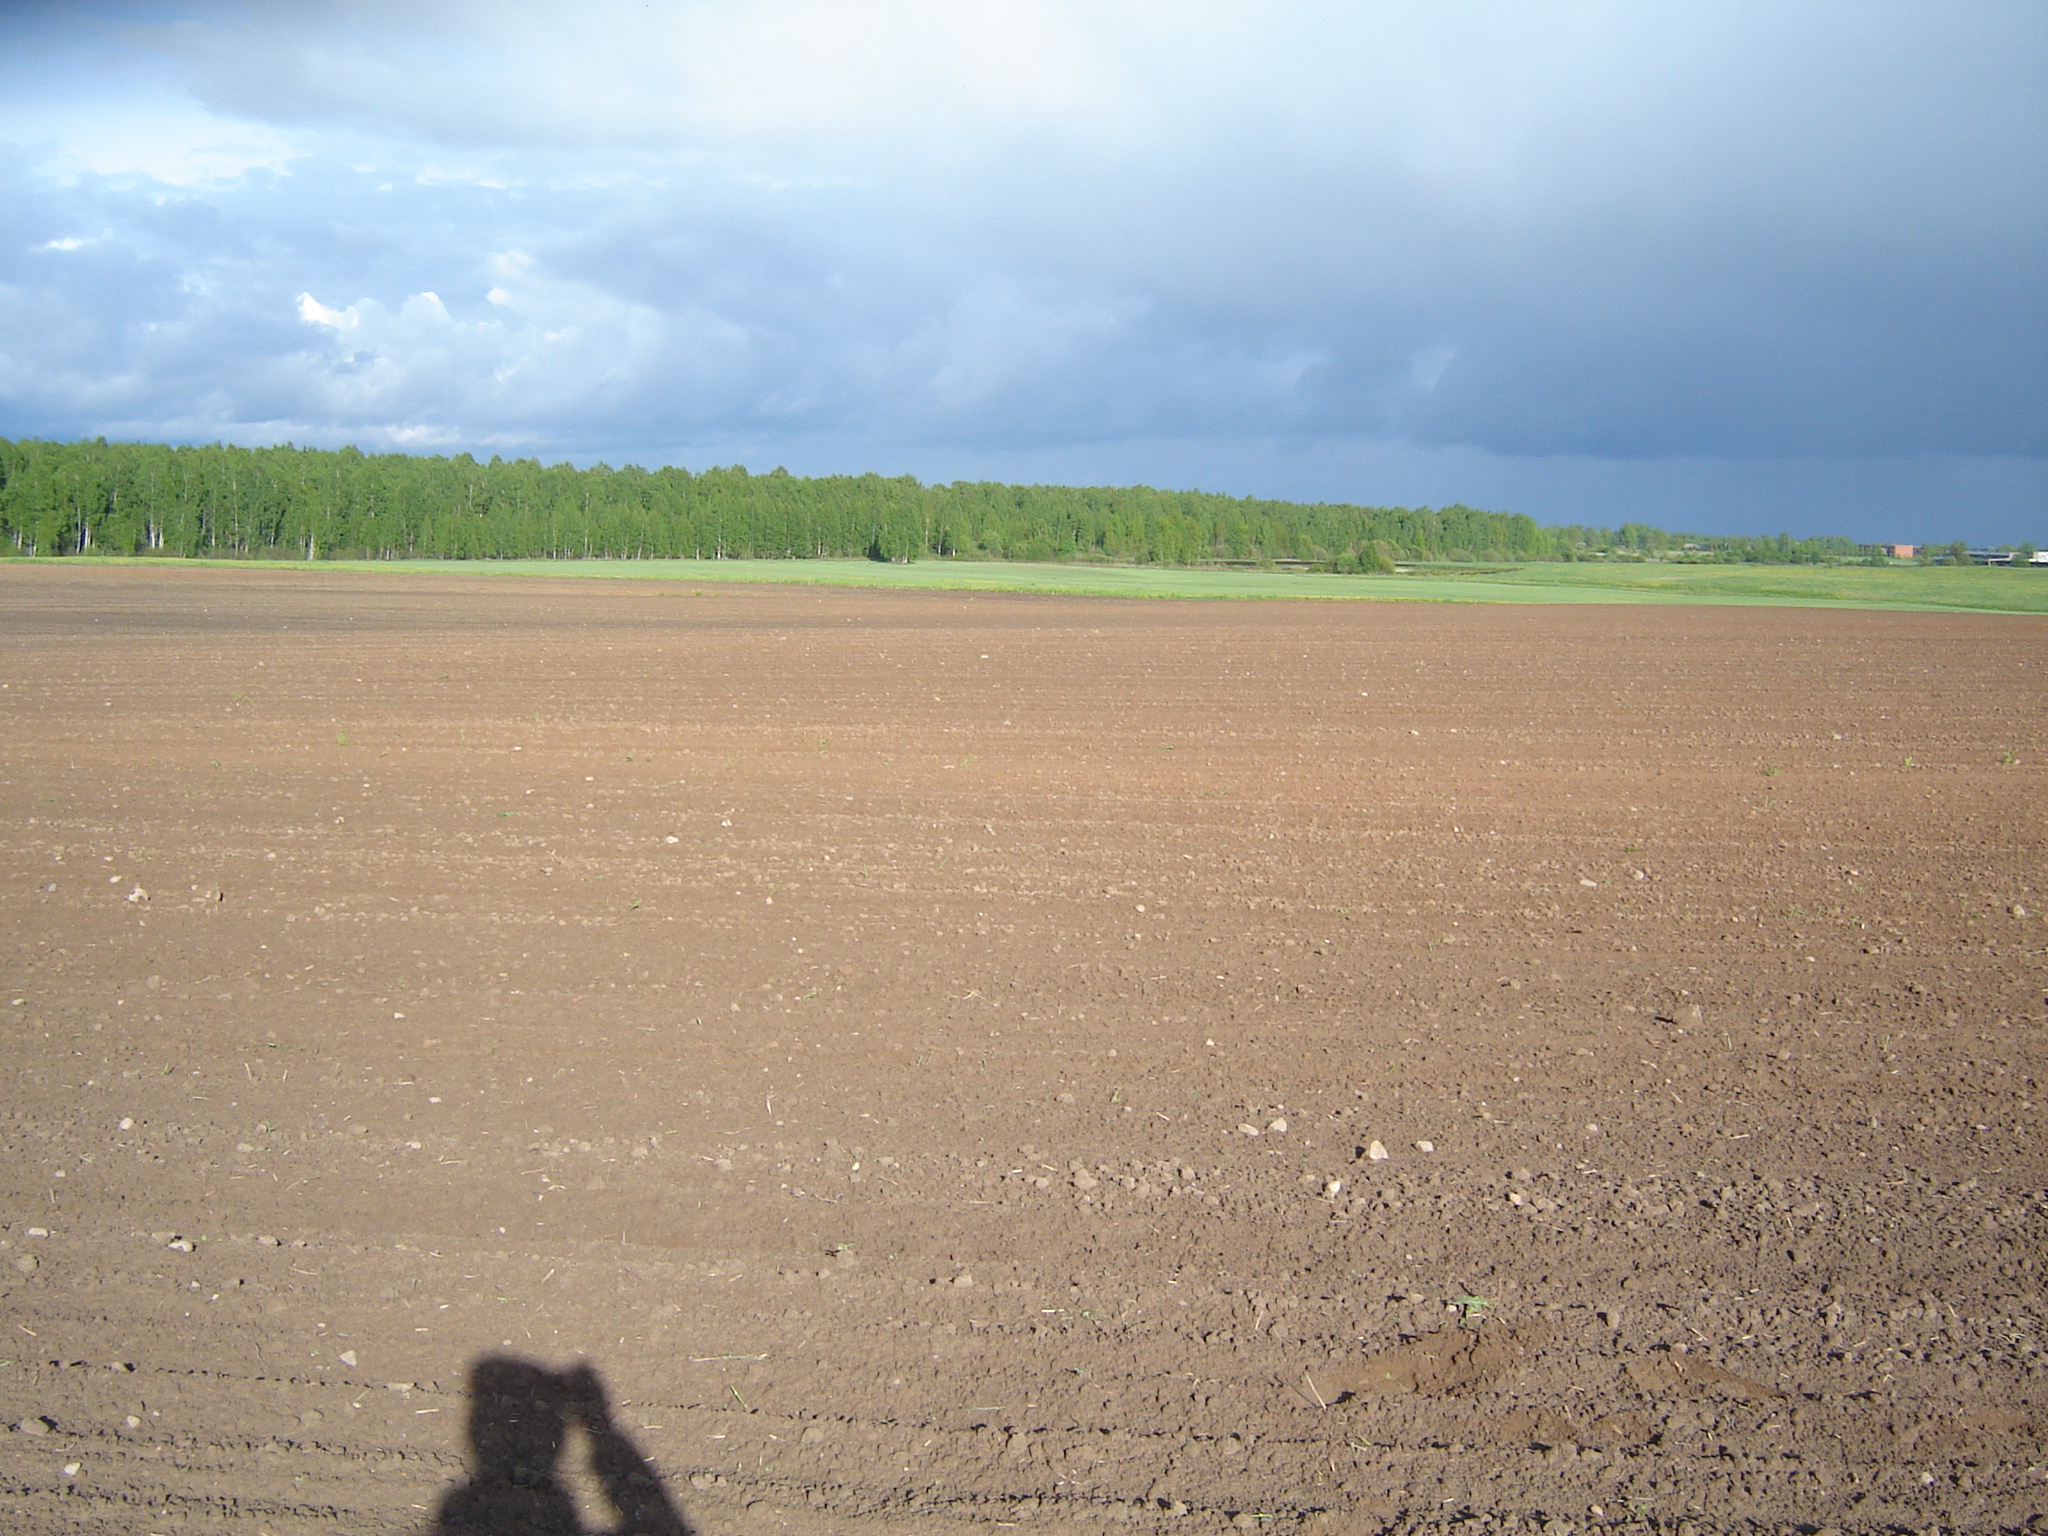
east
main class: Cropland
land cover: Oats
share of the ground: < 10 %
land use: Agriculture (excluding fallow land and kitchen gardens)
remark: Tilled/Sowed
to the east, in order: Oats; Grassland without tree/shrub cover
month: May
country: LT
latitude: 56.0658
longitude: 25.3285
